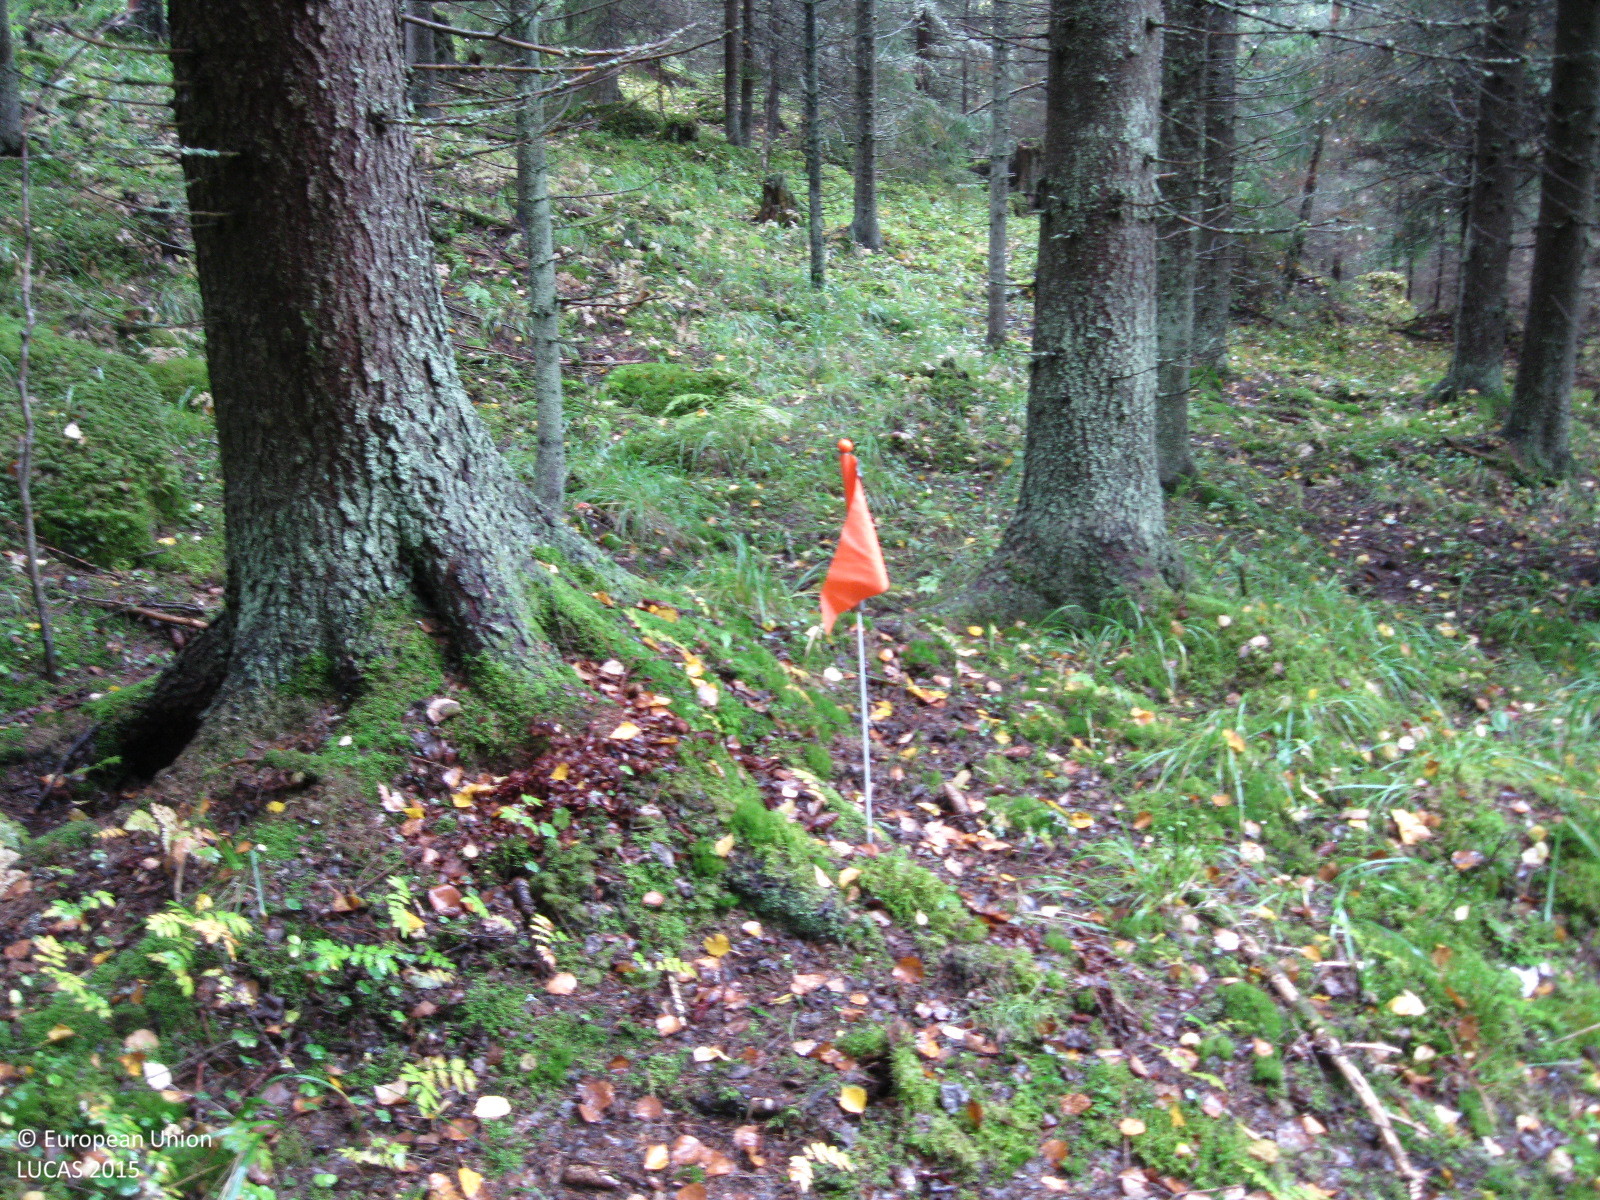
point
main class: Woodland
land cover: Spruce dominated coniferous woodland
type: boreal forest
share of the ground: > 75 %
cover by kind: coniferous forest trees 60 %, broadleaved forest trees 15 %, herbaceous plants 15 %, lichens and mosses 10 %
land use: Forestry
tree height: > 5 m
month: September
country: FI
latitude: 60.8309
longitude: 24.5810
